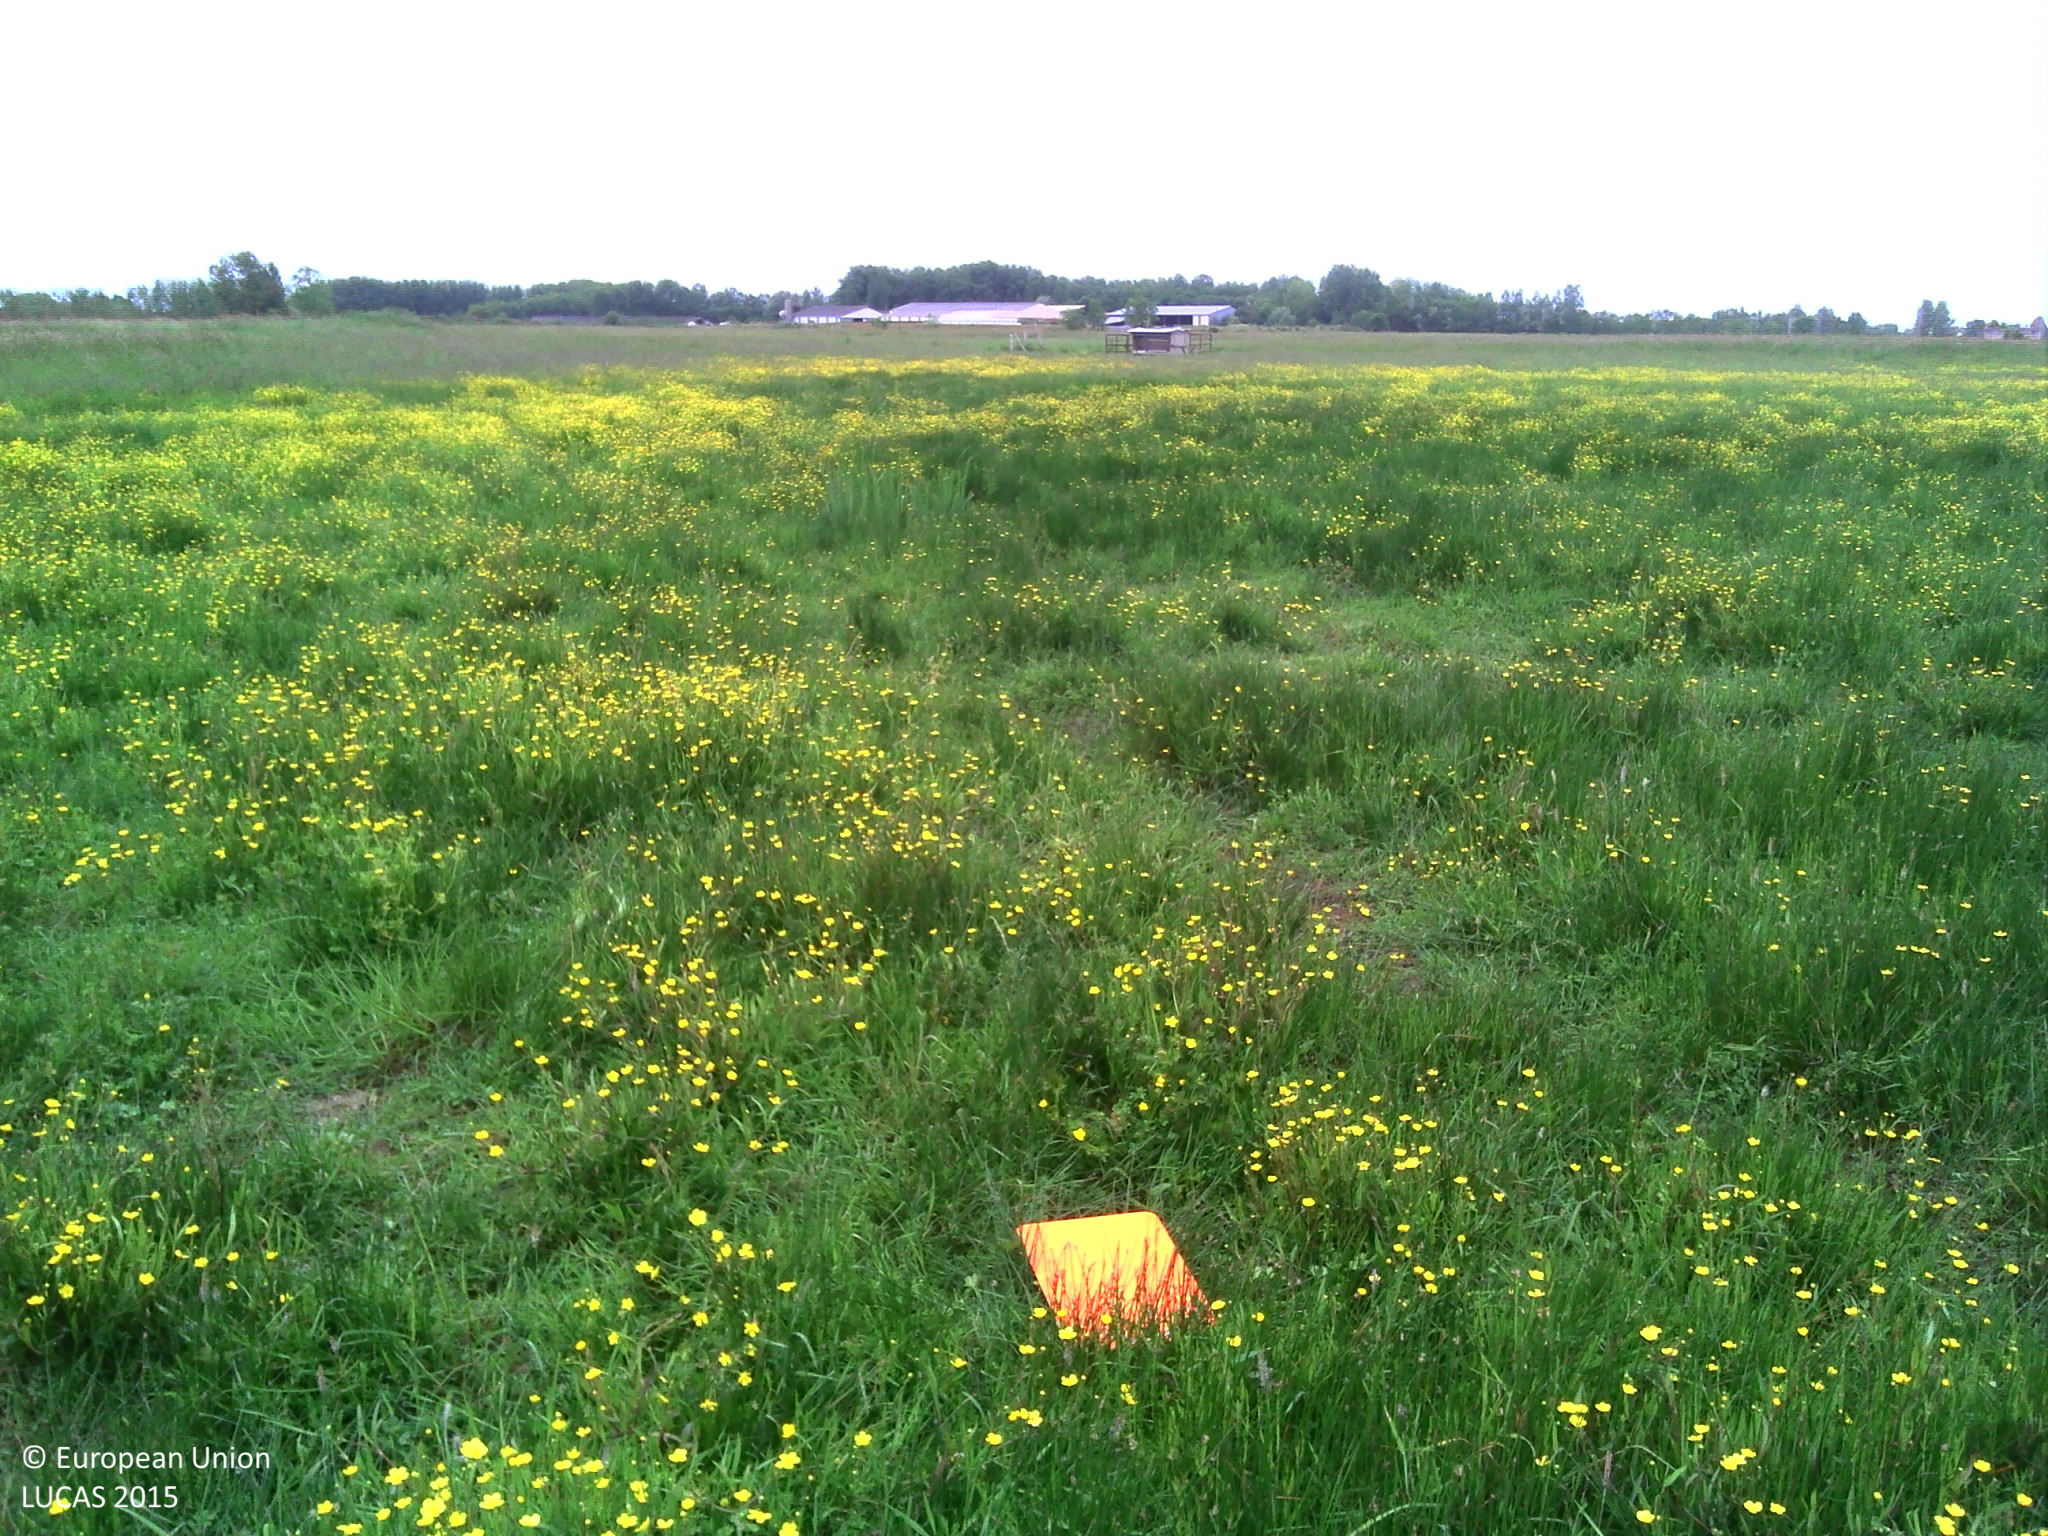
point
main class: Grassland
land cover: Grassland without tree/shrub cover
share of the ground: > 75 %
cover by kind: herbaceous plants 100 %
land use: Agriculture (excluding fallow land and kitchen gardens)
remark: Temporary flooded
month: June
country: FR
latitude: 46.8444
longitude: -1.9390
